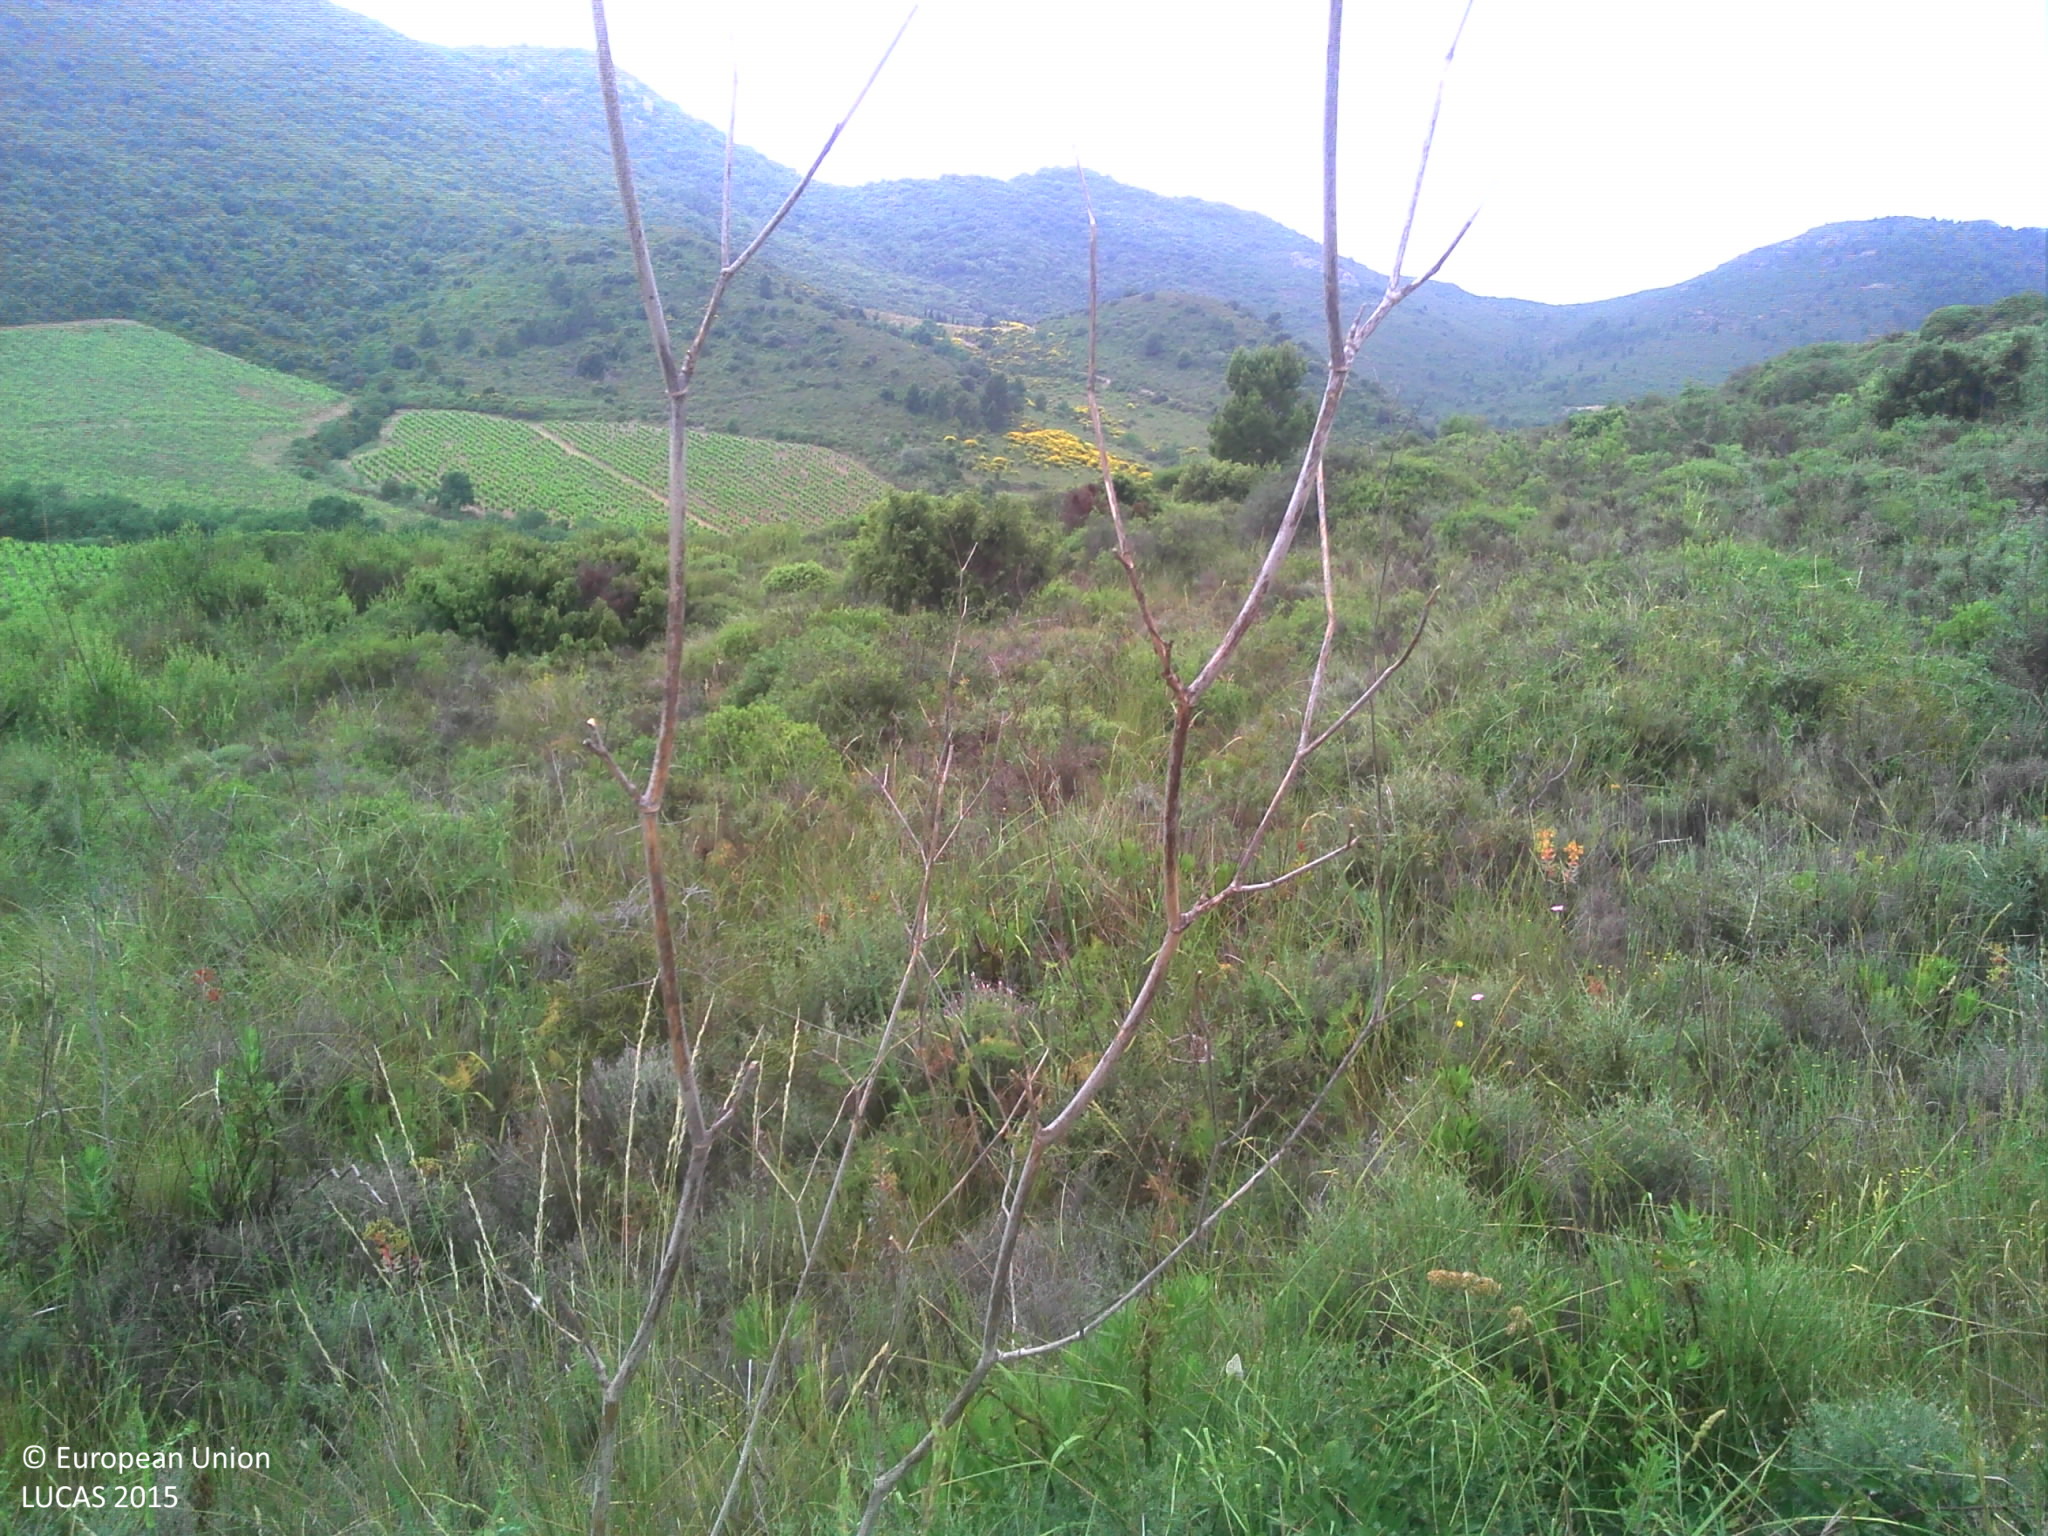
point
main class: Shrubland
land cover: Shrubland without tree cover
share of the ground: > 75 %
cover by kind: shrubs 90 %, herbaceous plants 10 %
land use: Semi-natural and natural areas not in use
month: June
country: FR
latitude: 42.9783
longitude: 2.8123
